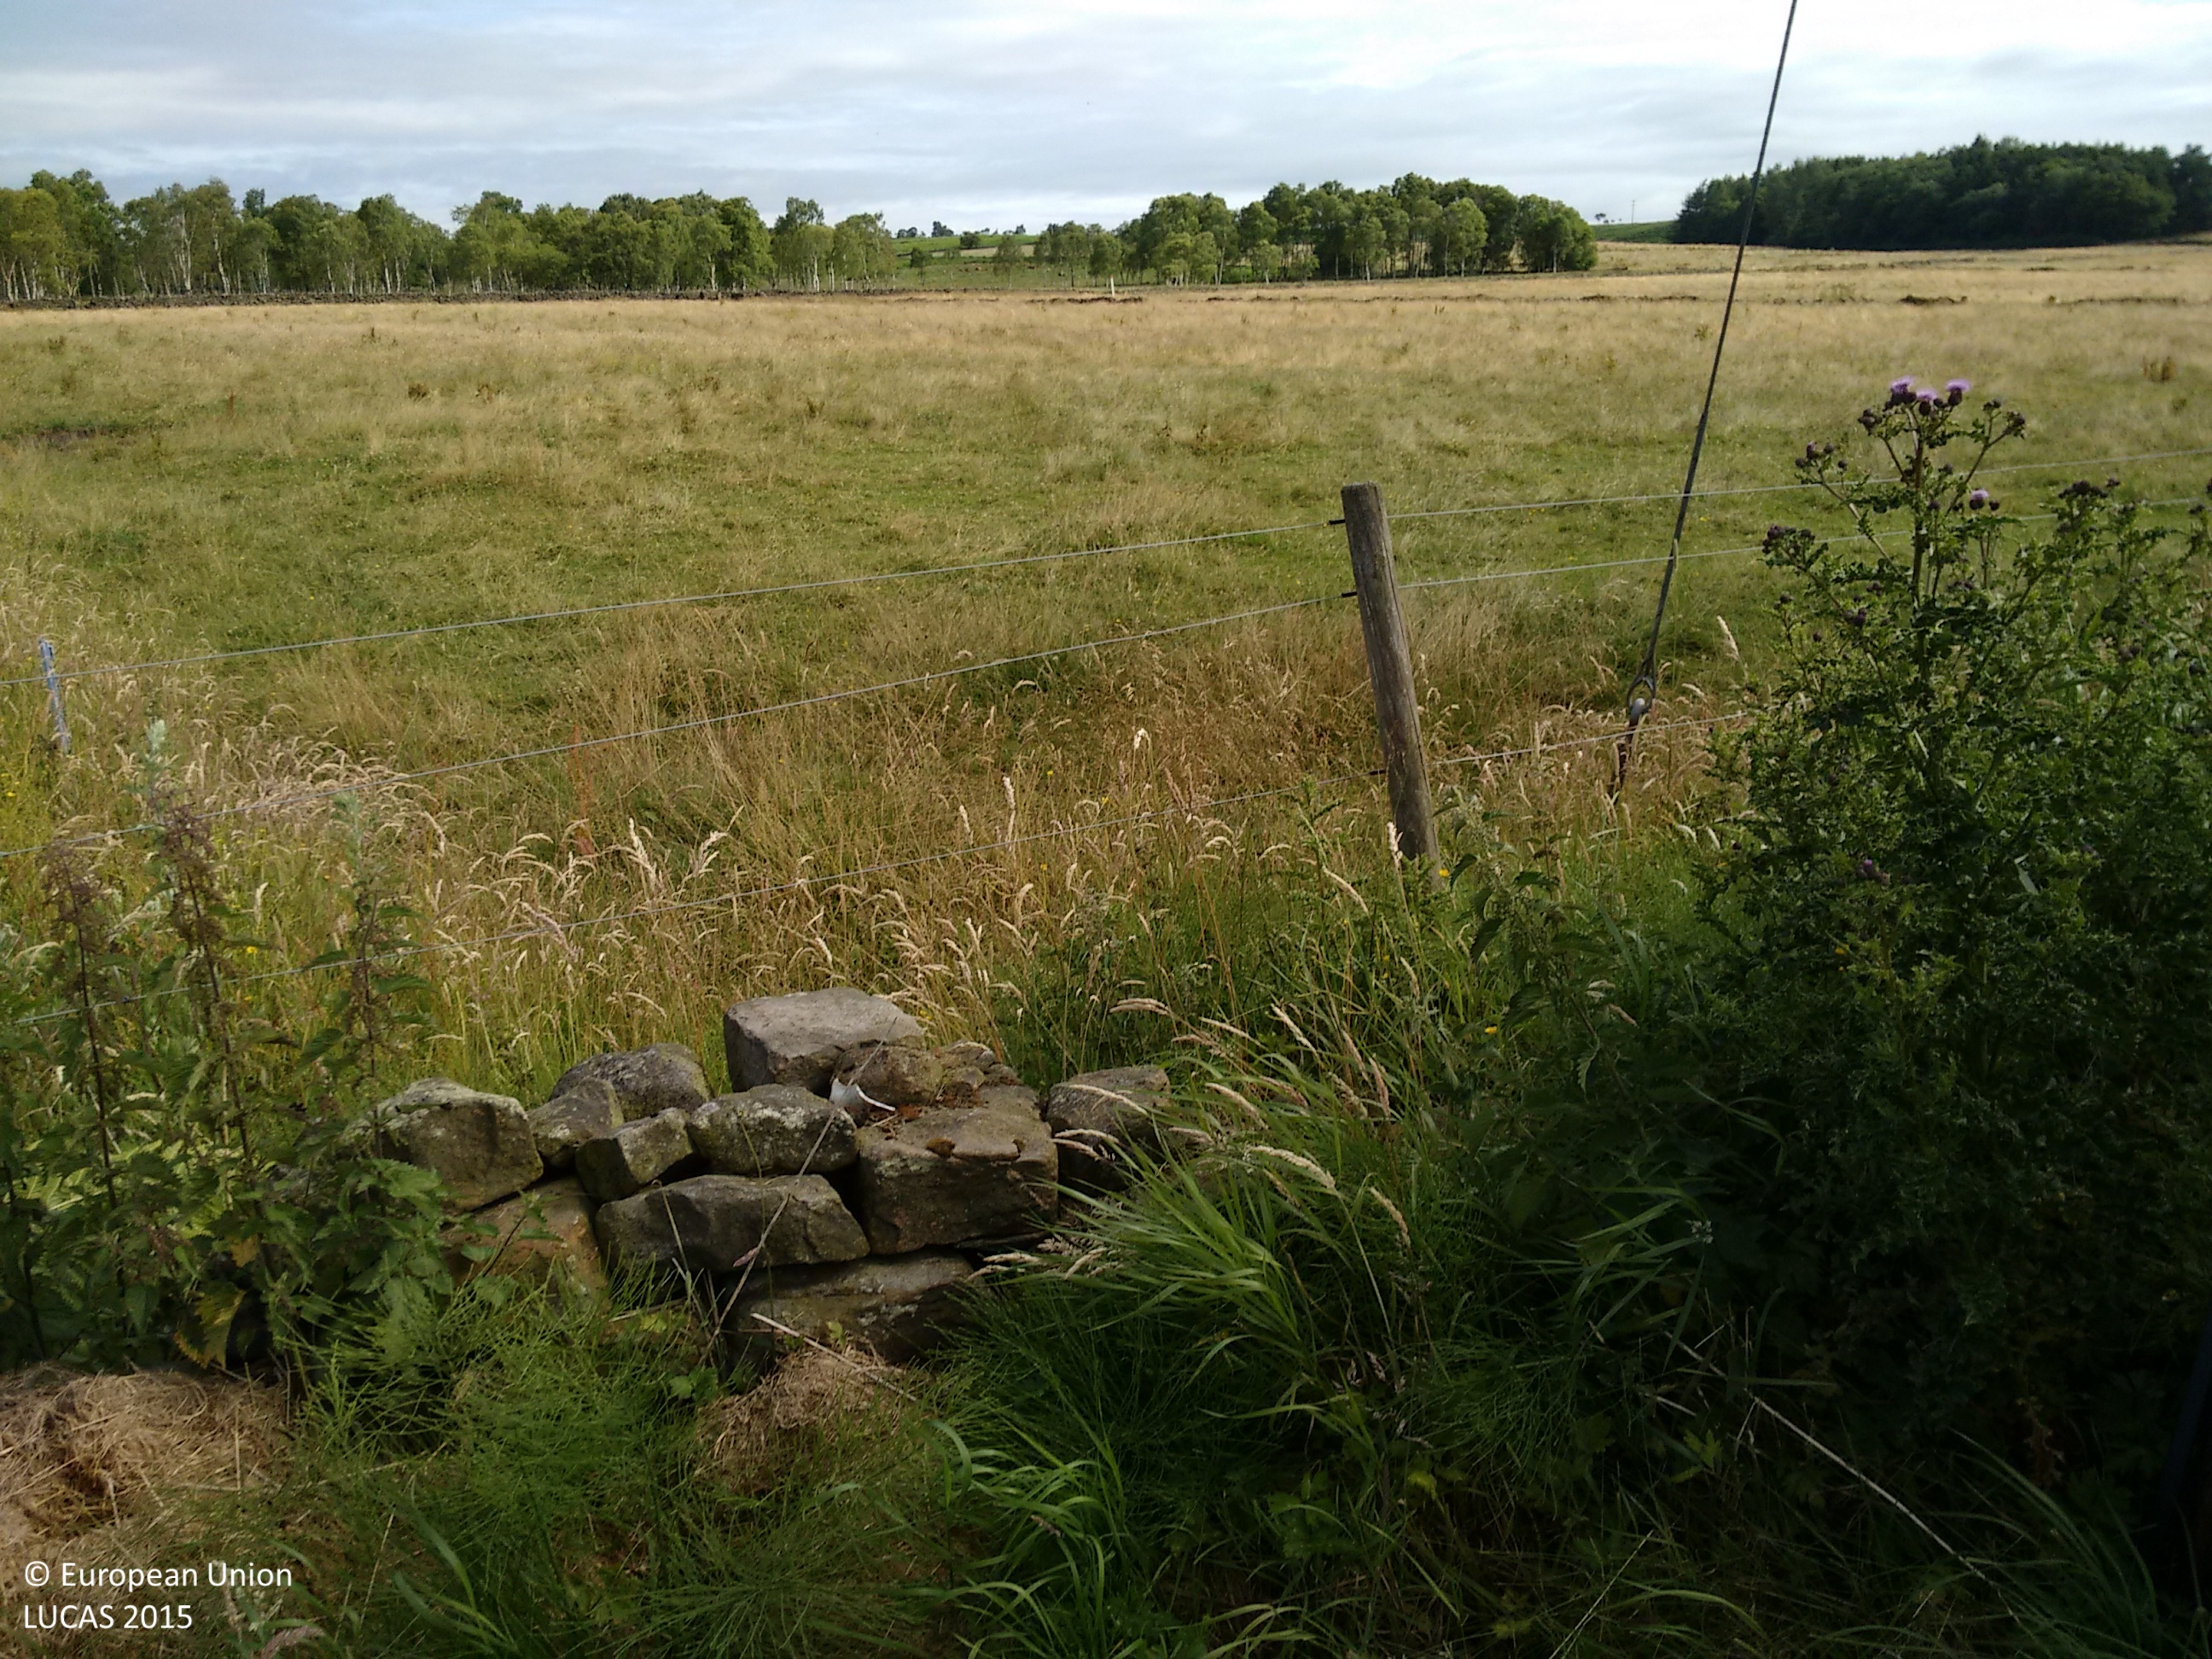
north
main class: Grassland
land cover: Grassland without tree/shrub cover
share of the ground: > 75 %
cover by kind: herbaceous plants 100 %
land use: Agriculture (excluding fallow land and kitchen gardens)
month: July
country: GB
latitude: 53.2444
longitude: -1.5752
